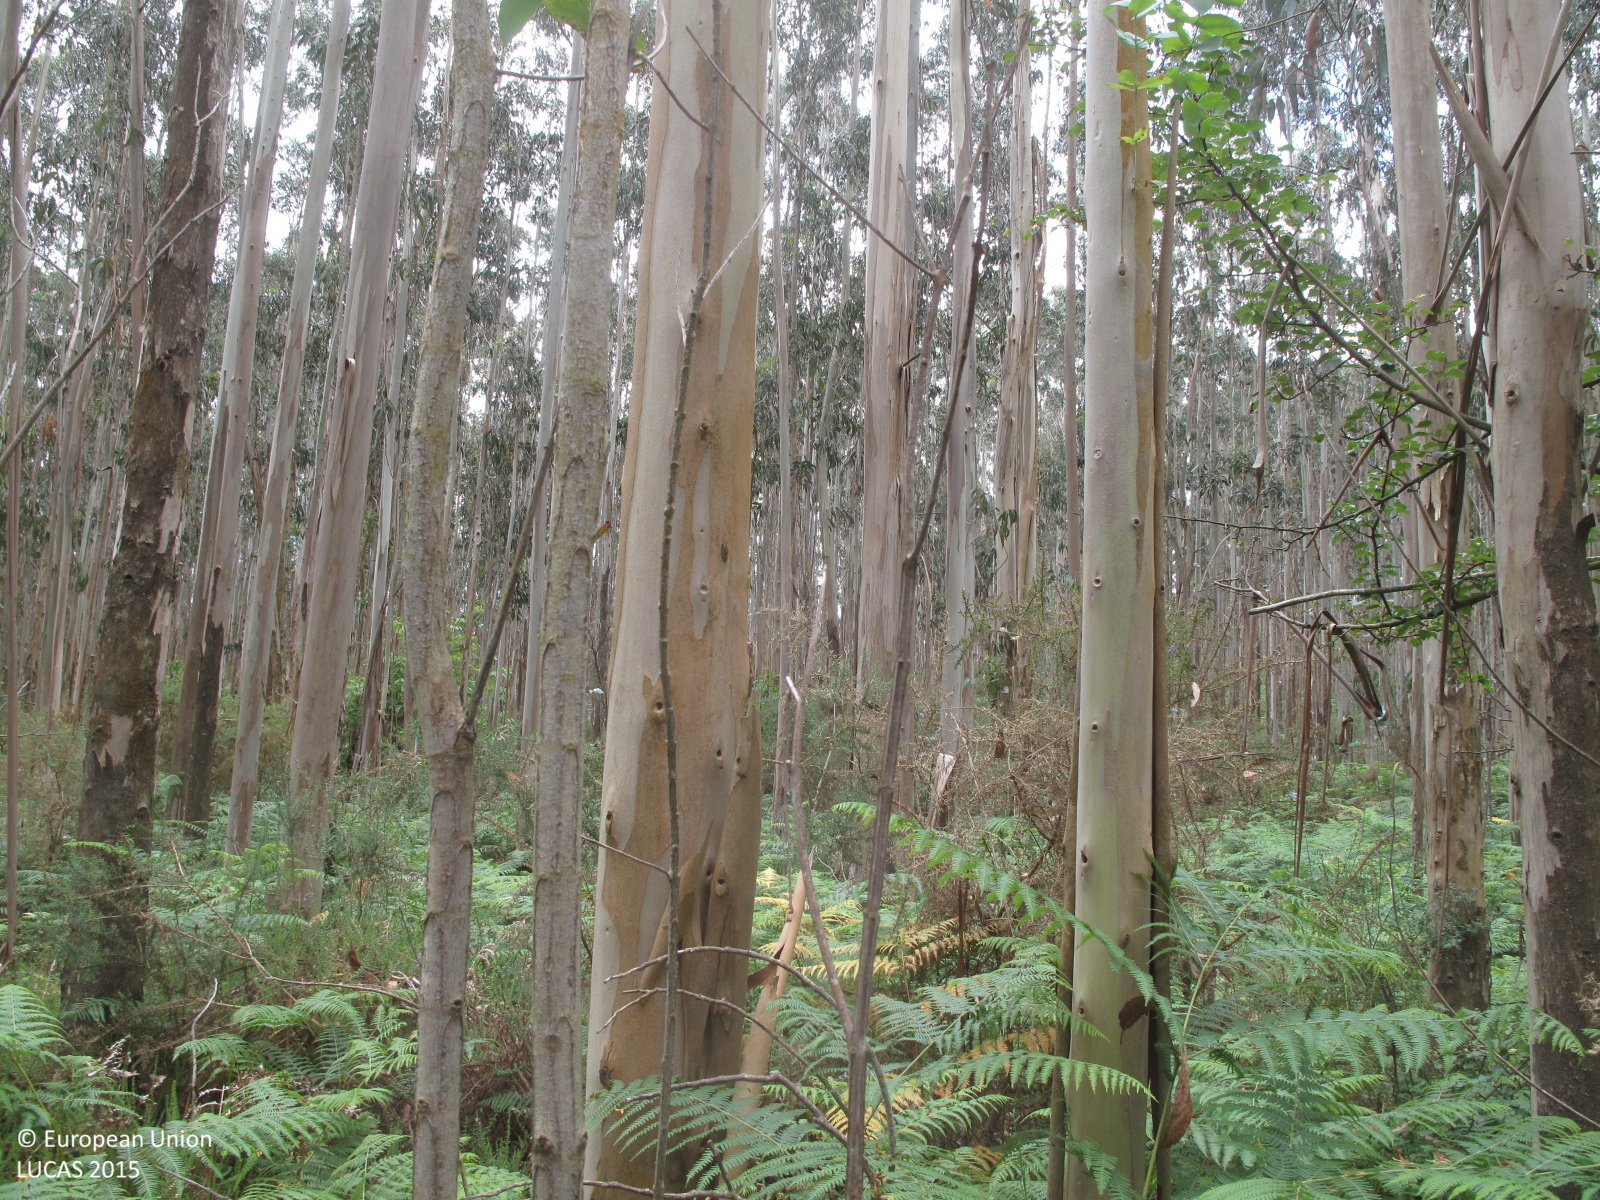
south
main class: Woodland
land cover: Broadleaved woodland
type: exotic forest
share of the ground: > 75 %
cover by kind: broadleaved forest trees 80 %, herbaceous plants 15 %, shrubs 5 %
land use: Forestry
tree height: > 5 m
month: July
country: ES
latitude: 43.6177
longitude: -8.0546
